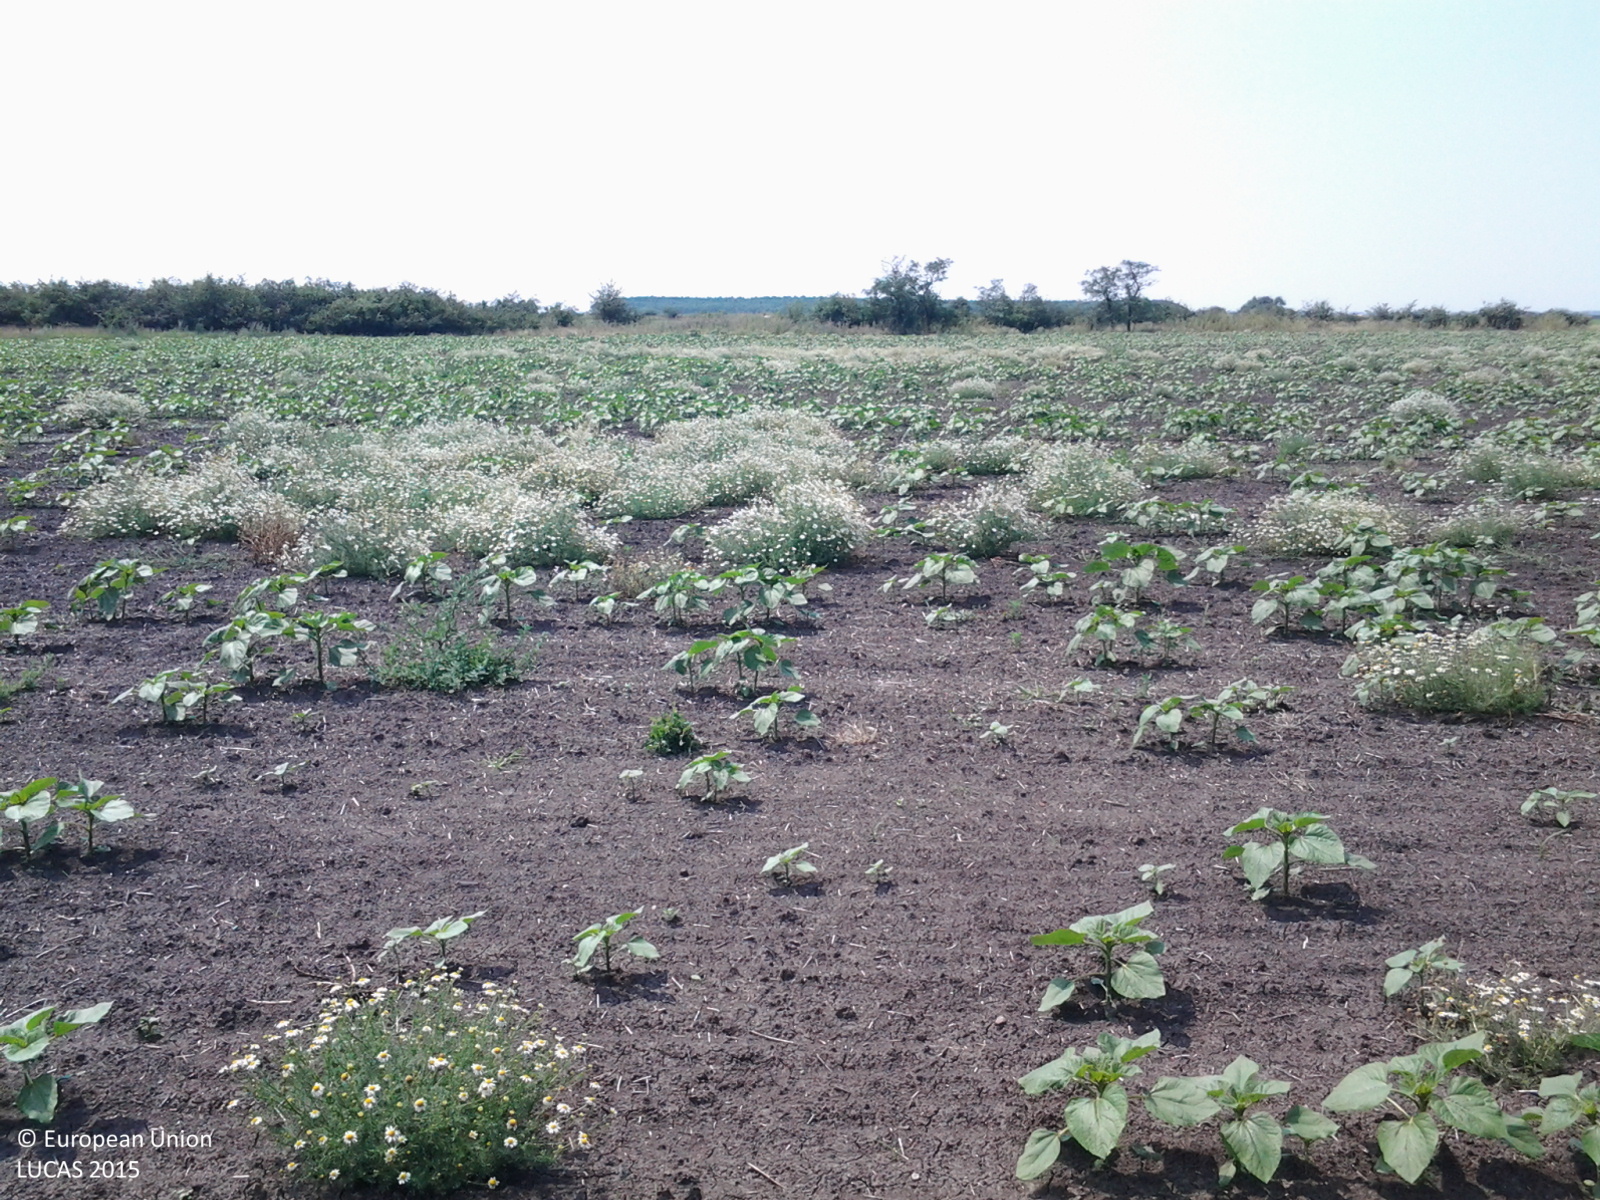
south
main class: Cropland
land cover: Sunflower
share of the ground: 25 - 50 %
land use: Agriculture (excluding fallow land and kitchen gardens)
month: July
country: HU
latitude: 46.9761
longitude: 20.5056
